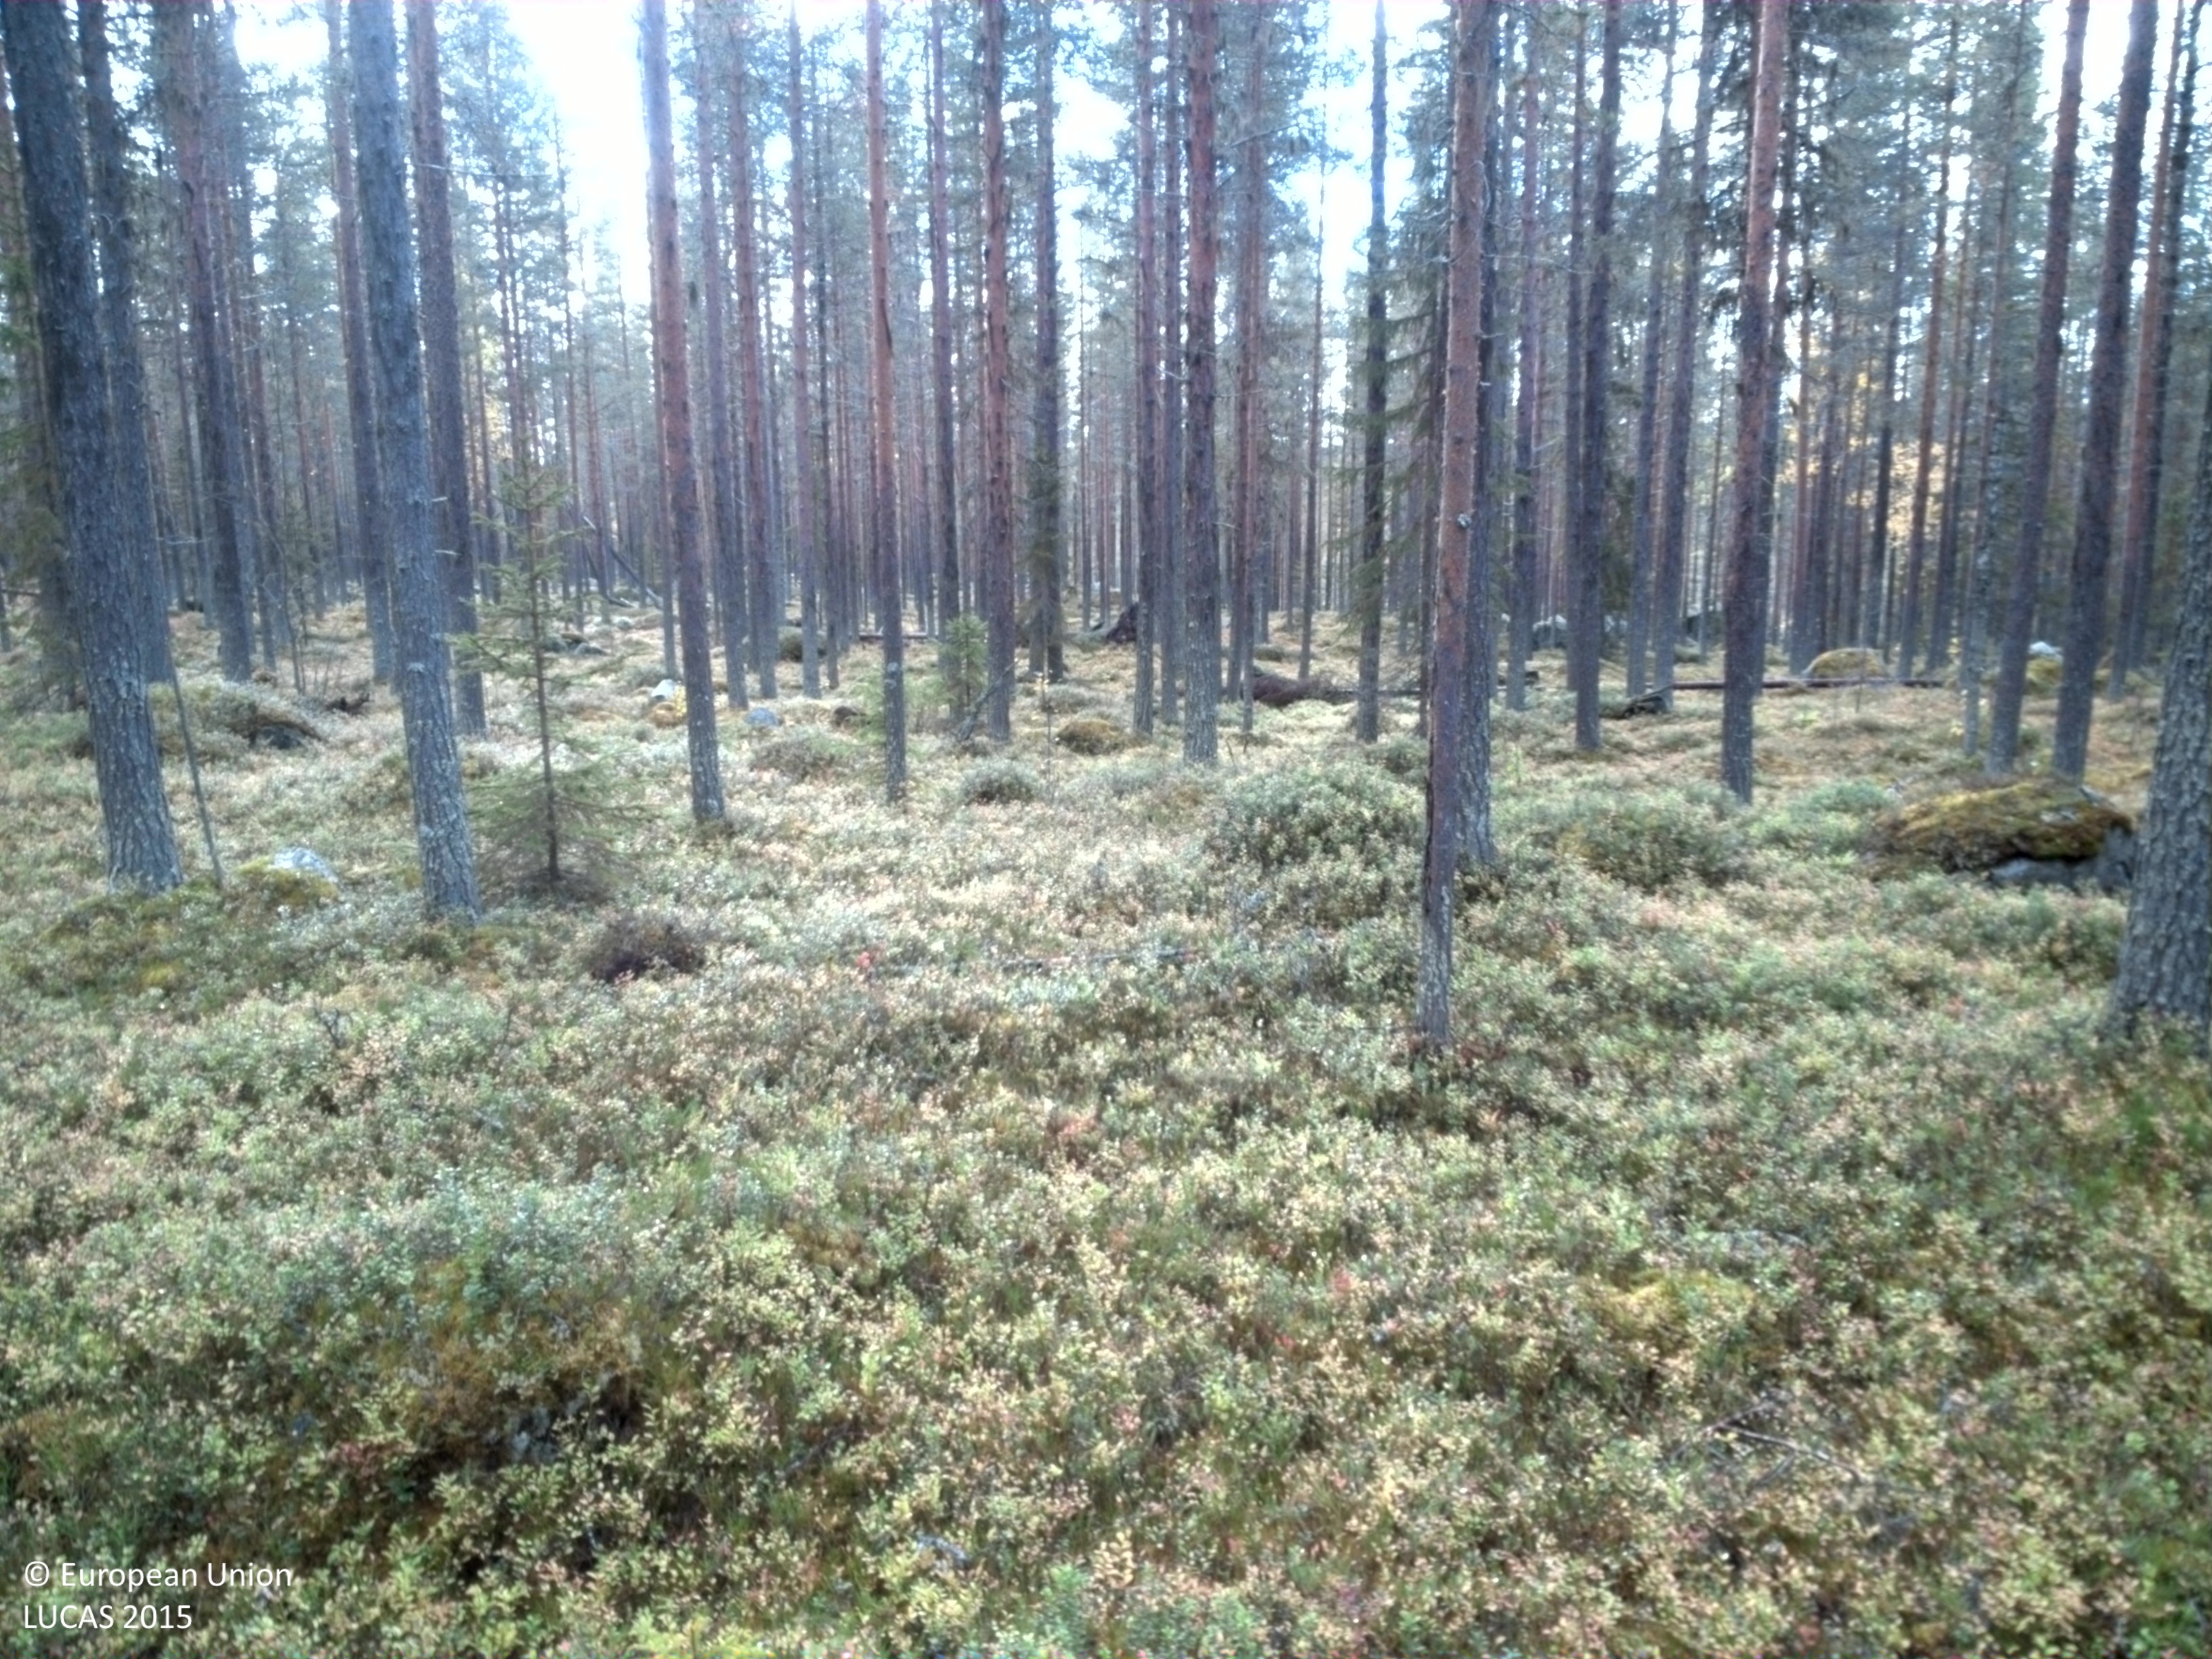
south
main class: Woodland
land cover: Pine dominated coniferous woodland
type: boreal forest
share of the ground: 25 - 50 %
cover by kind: shrubs 45 %, coniferous forest trees 35 %, lichens and mosses 20 %
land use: Forestry
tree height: > 5 m
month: September
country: SE
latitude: 65.1254
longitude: 17.5691
